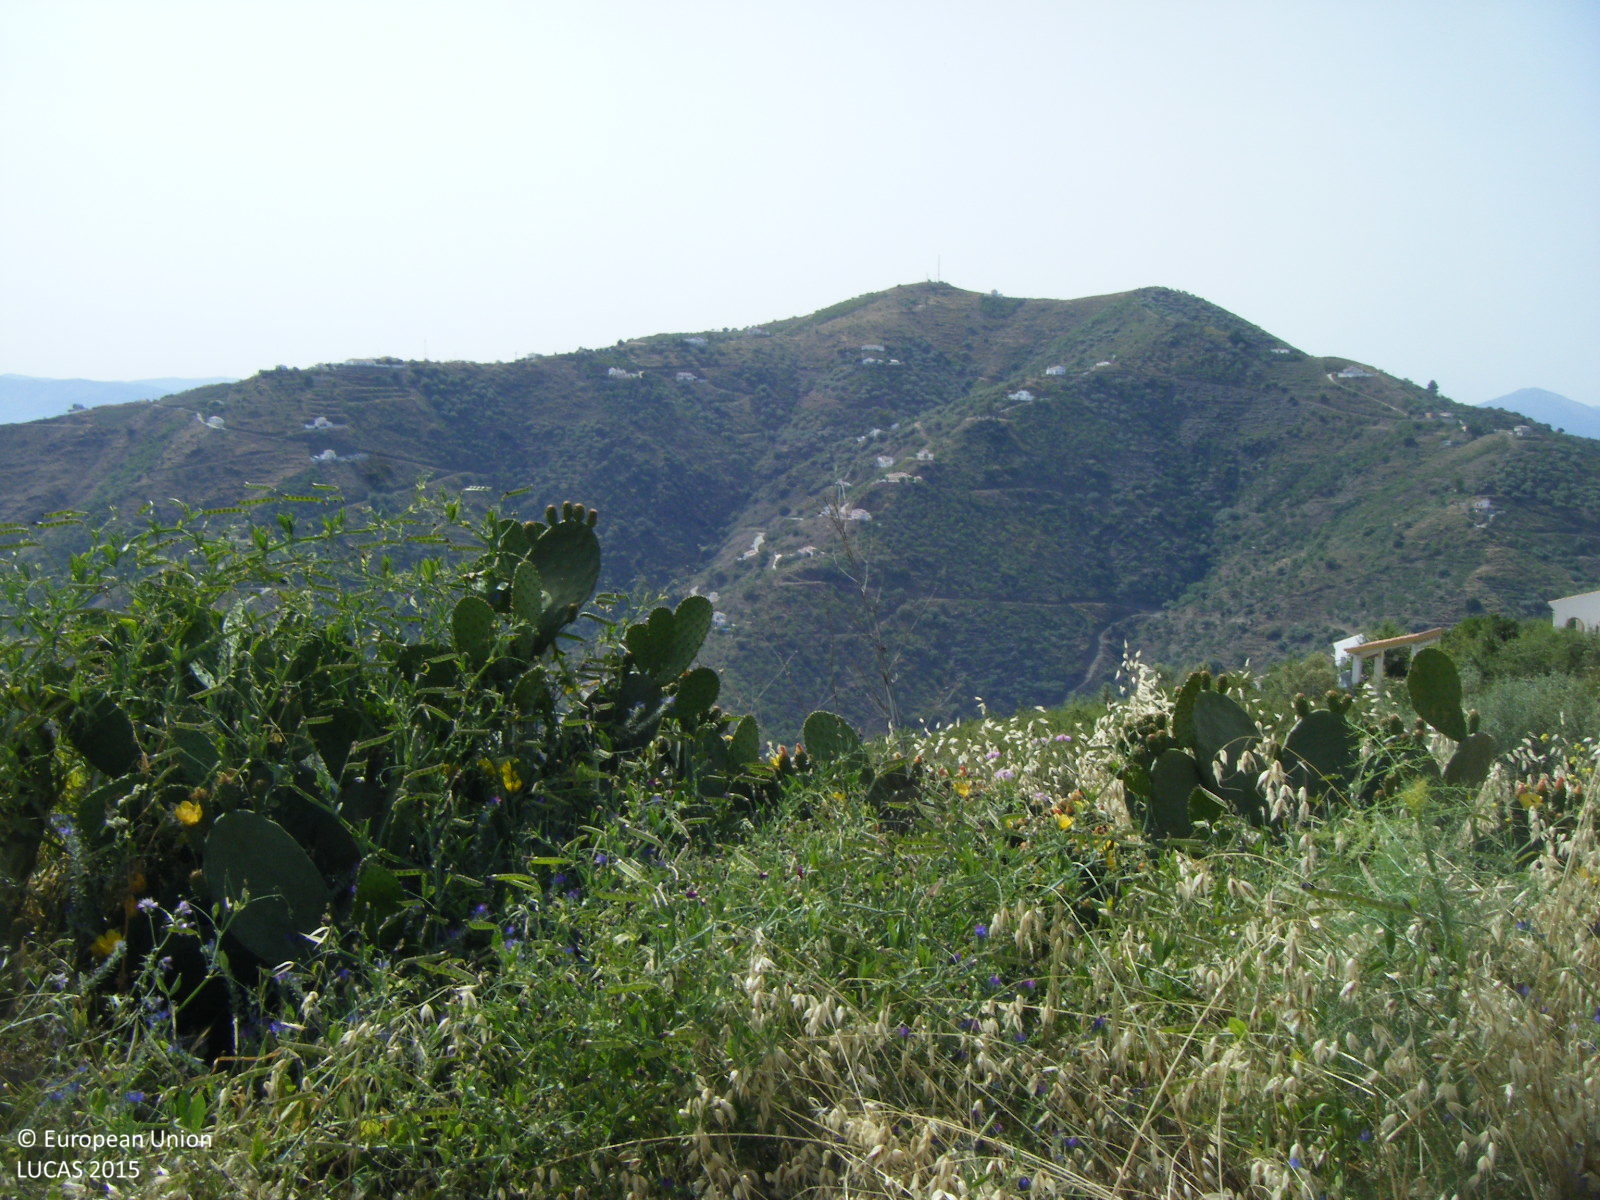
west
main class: Grassland
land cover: Grassland without tree/shrub cover
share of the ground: > 75 %
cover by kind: herbaceous plants 100 %
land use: Semi-natural and natural areas not in use
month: May
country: ES
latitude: 36.8084
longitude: -4.0547
